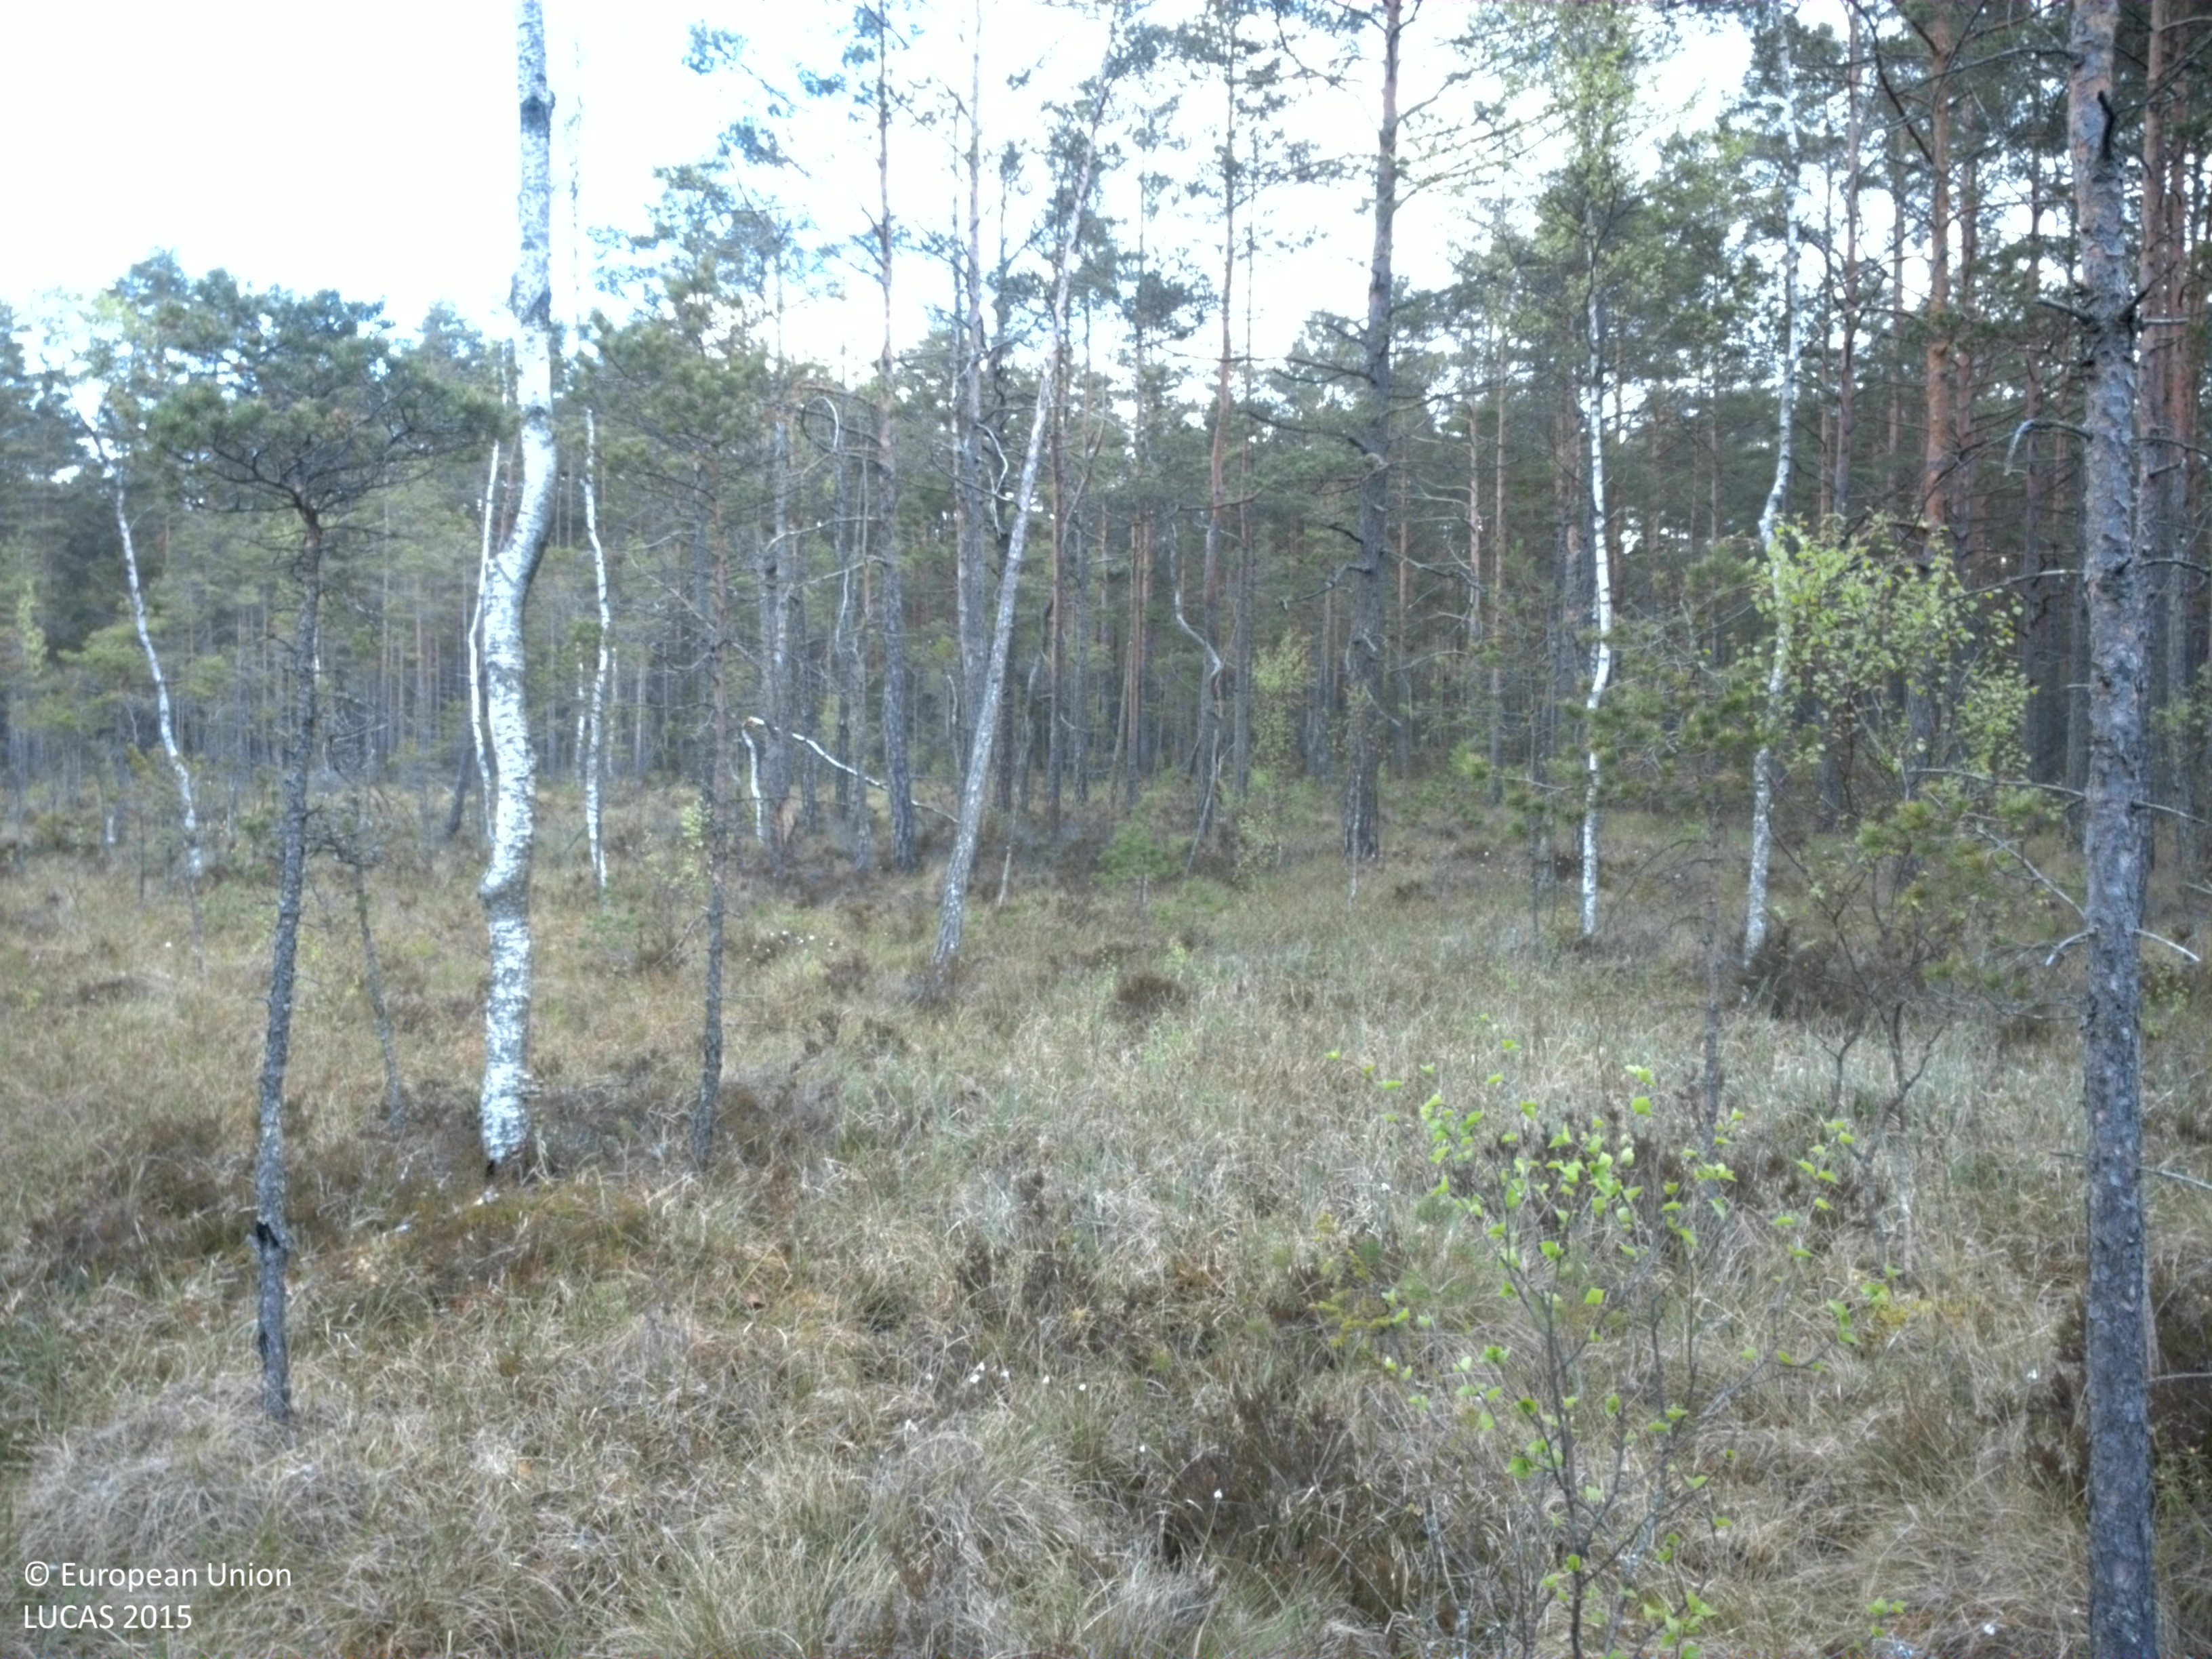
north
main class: Woodland
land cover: Pine dominated mixed woodland
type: boreal forest
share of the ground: 50 - 75 %
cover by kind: coniferous forest trees 35 %, broadleaved forest trees 35 %, lichens and mosses 30 %
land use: Forestry
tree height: > 5 m
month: May
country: SE
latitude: 56.5926
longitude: 14.5735
